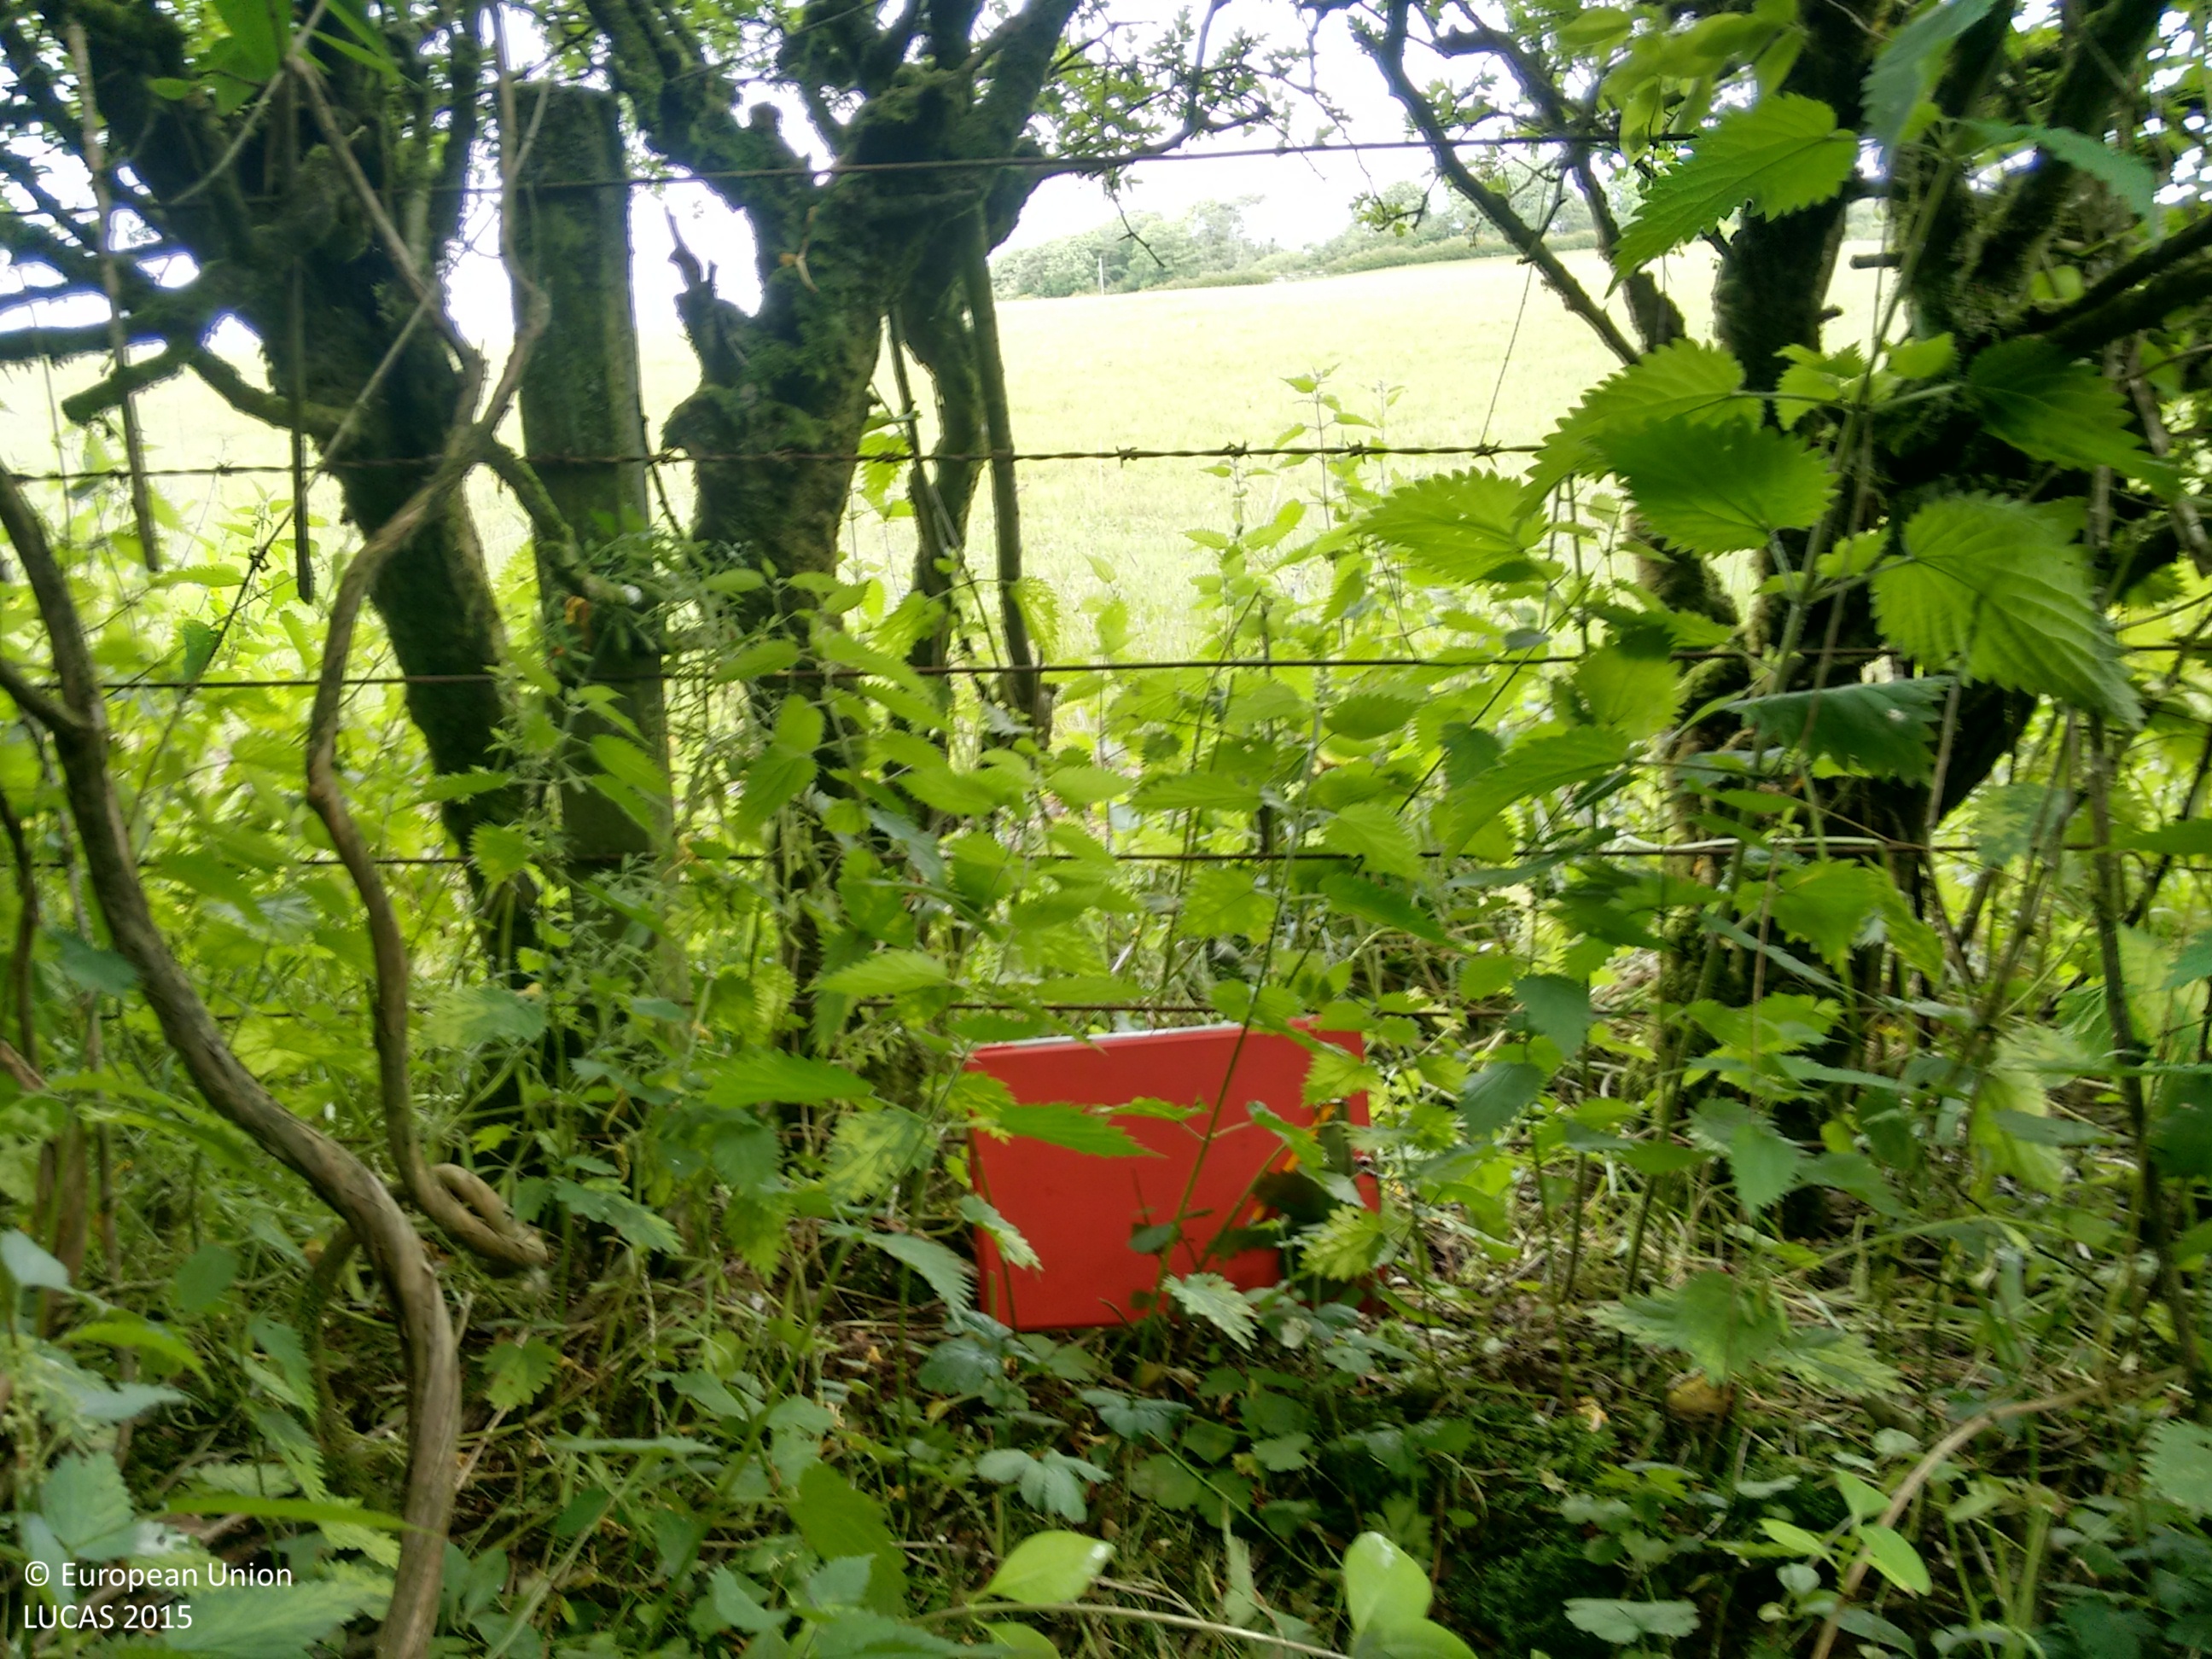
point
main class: Grassland
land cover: Grassland without tree/shrub cover
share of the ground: < 10 %
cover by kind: herbaceous plants 100 %
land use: Agriculture (excluding fallow land and kitchen gardens)
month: July
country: GB
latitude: 55.5372
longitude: -4.3740
